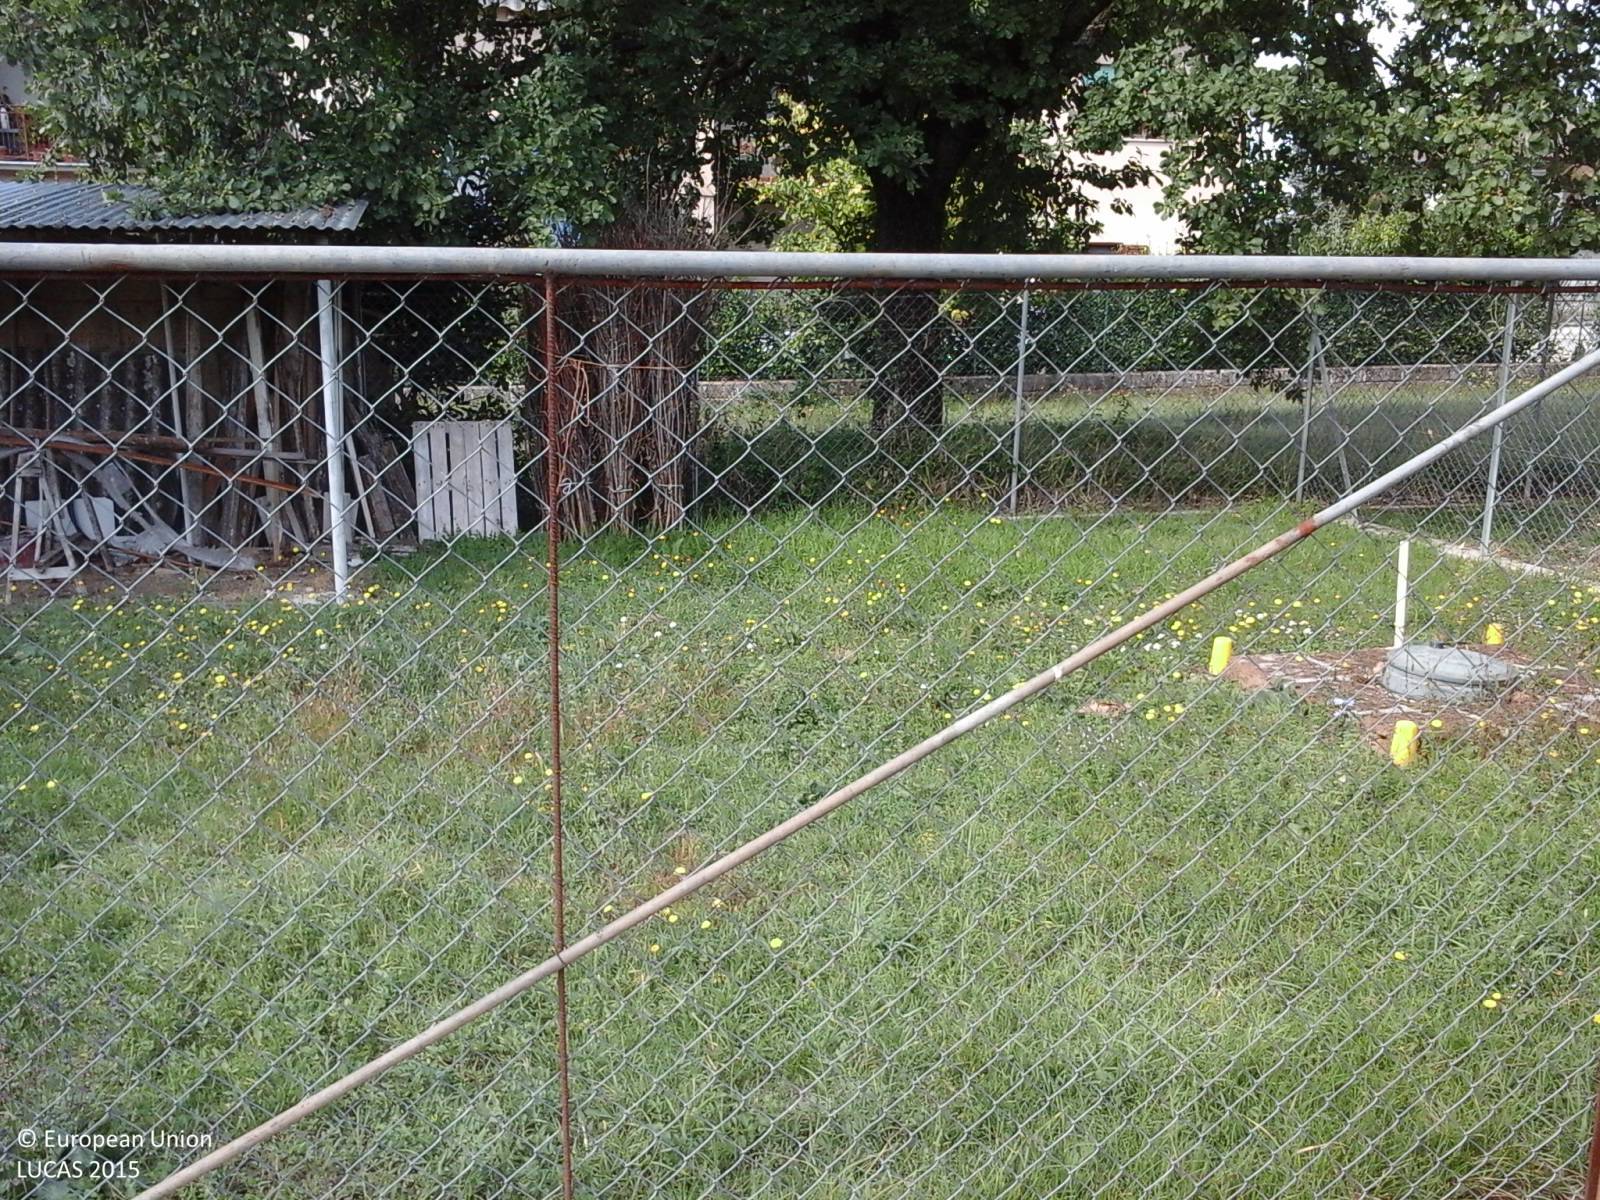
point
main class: Grassland
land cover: Grassland without tree/shrub cover
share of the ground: > 75 %
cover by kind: herbaceous plants 100 %
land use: Residential
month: October
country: IT
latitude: 42.4687
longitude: 12.8732
